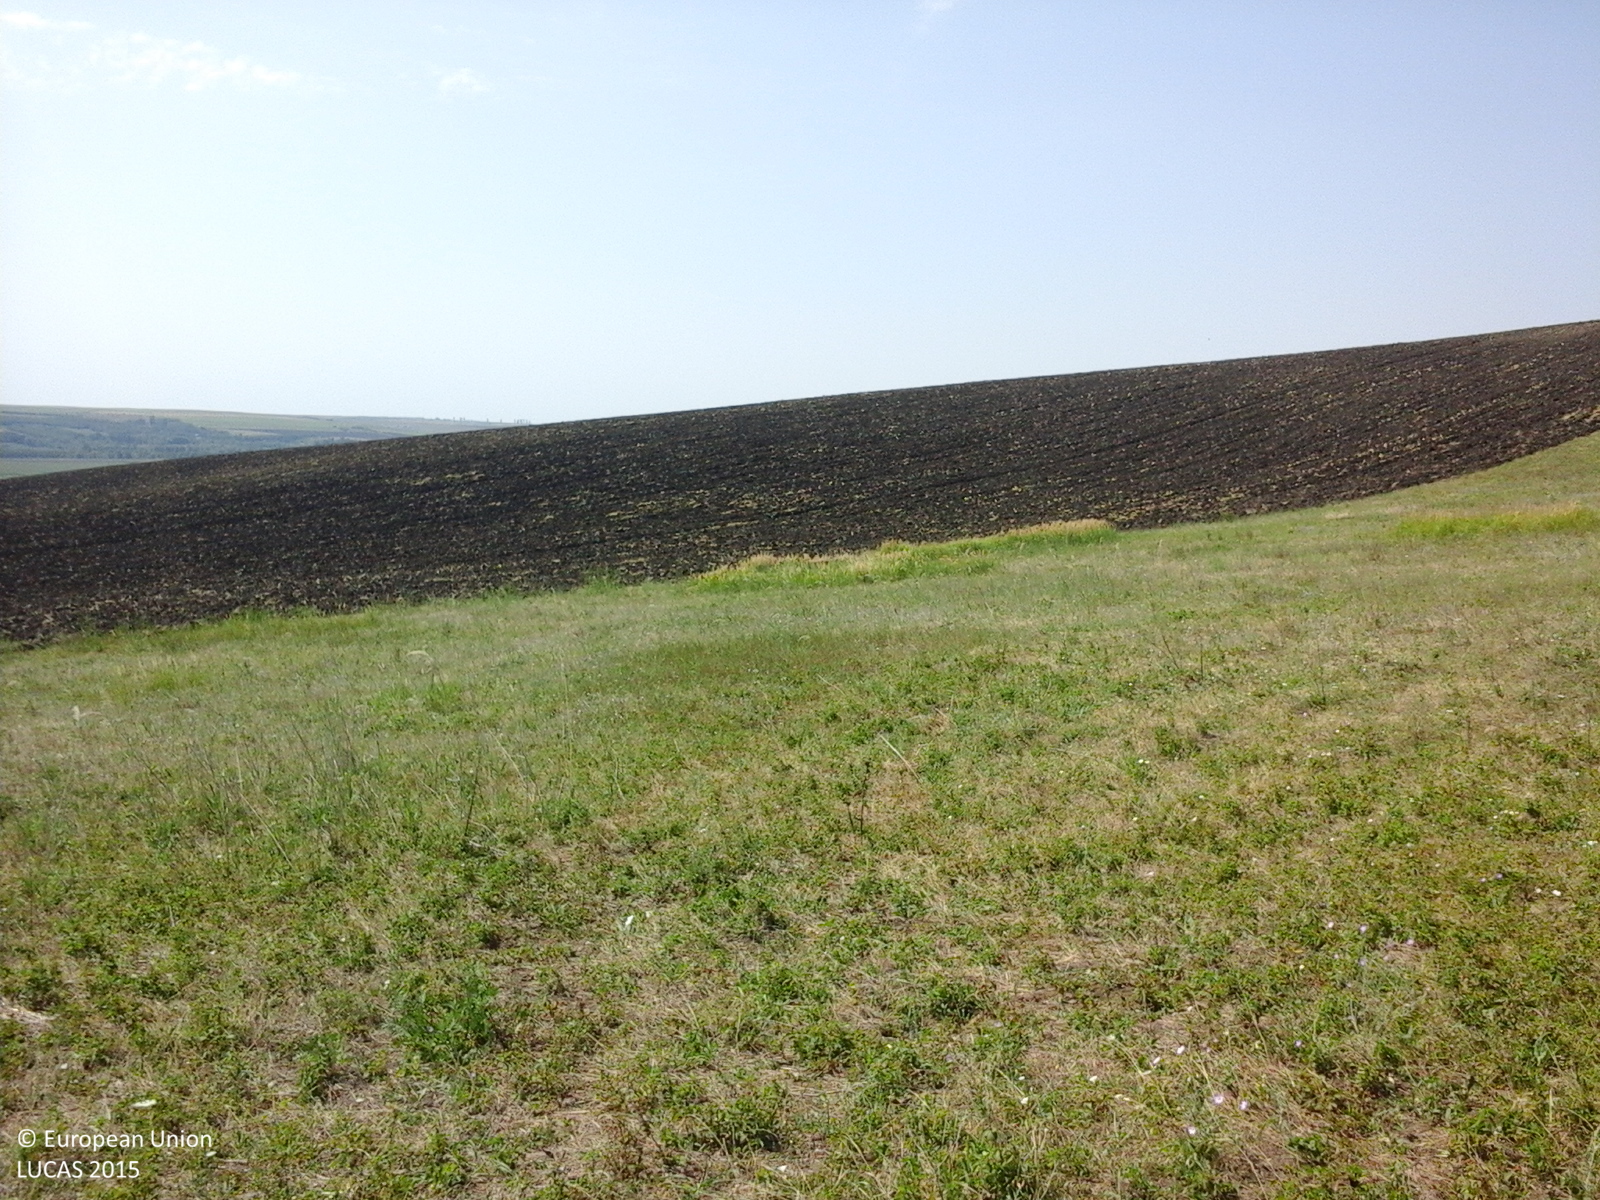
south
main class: Grassland
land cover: Grassland without tree/shrub cover
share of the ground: > 75 %
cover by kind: herbaceous plants 100 %
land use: Agriculture (excluding fallow land and kitchen gardens)
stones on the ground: < 10 %
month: July
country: RO
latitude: 46.1078
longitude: 27.5089
